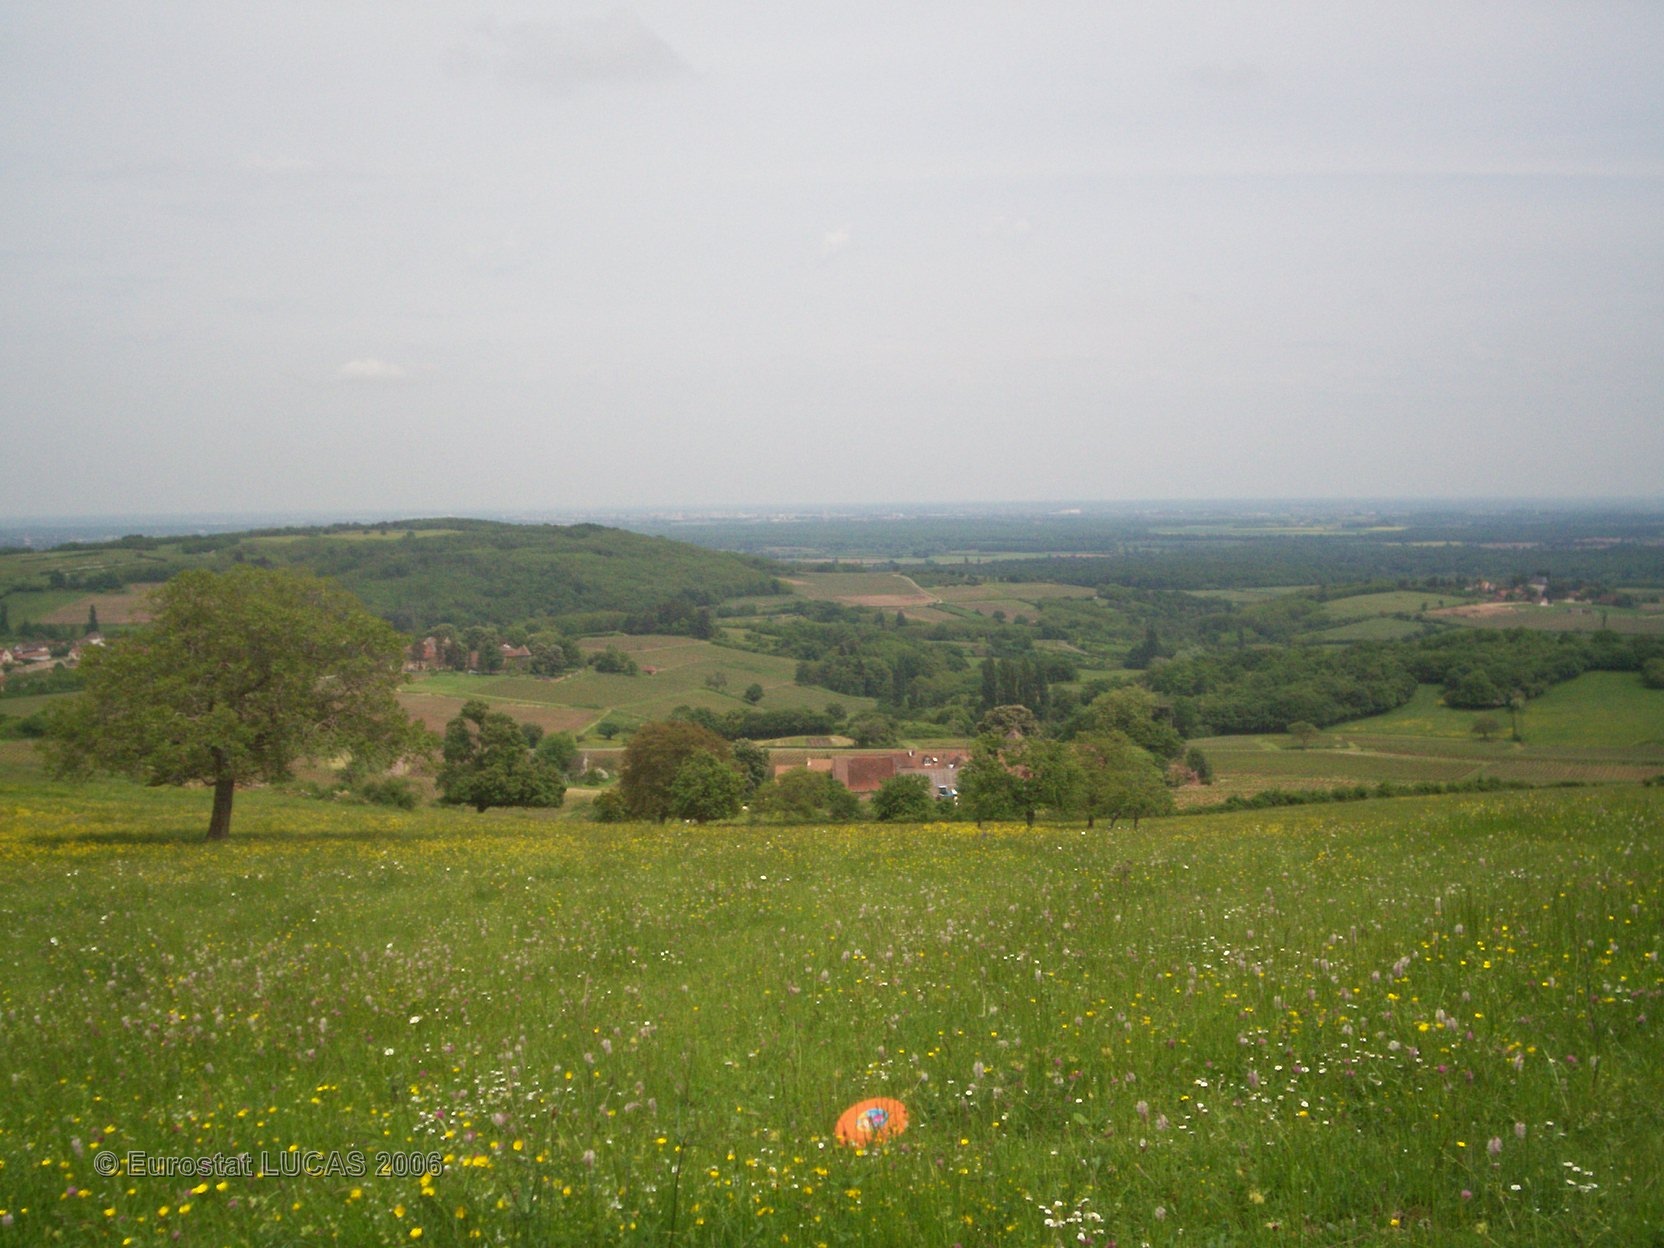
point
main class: Grassland
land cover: Grassland without tree/shrub cover
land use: Agriculture (excluding fallow land and kitchen gardens)
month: May
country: FR
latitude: 46.7240
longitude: 4.6759
